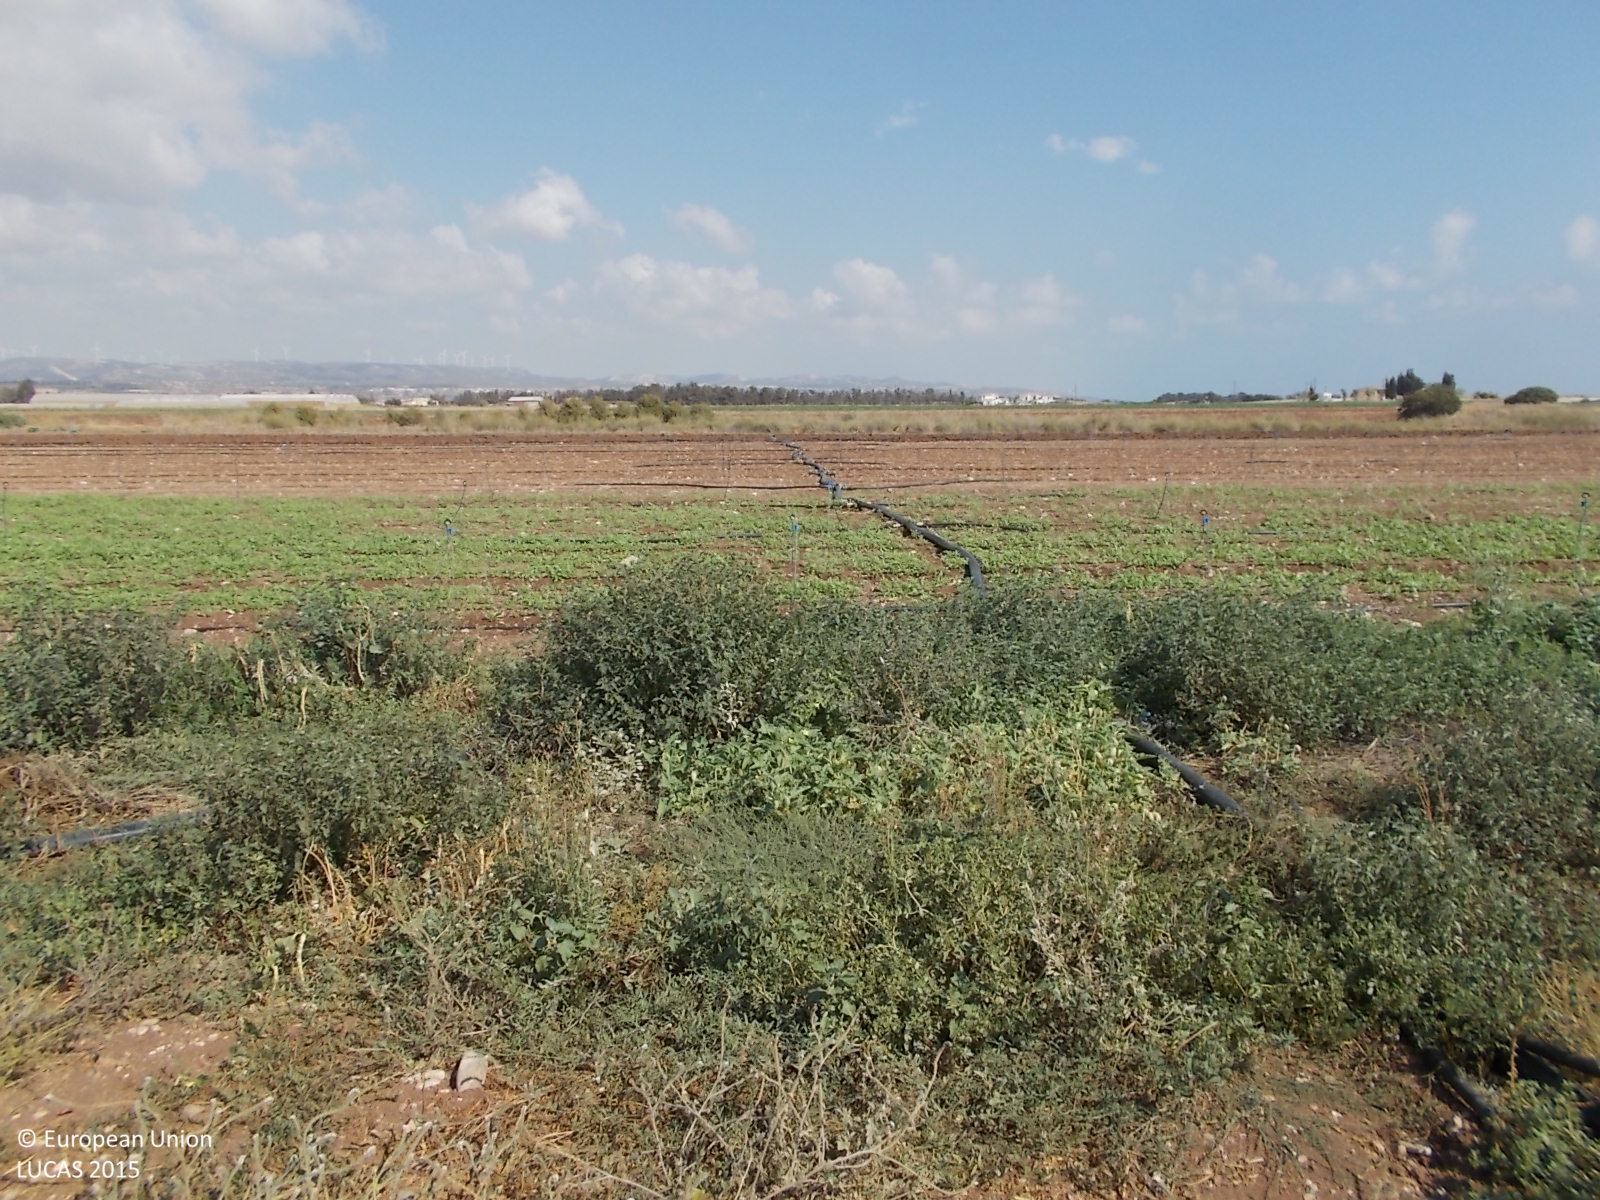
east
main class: Cropland
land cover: Dry pulses
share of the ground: 25 - 50 %
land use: Agriculture (excluding fallow land and kitchen gardens)
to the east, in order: Dry pulses; Grass margins; Other bare soil; Spontaneously vegetated surfaces; Broadleaved woodland; Ditches and canals; Broadleaved woodland; Spontaneously vegetated surfaces; Other bare soil
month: May
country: CY
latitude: 34.7099
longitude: 32.5177
